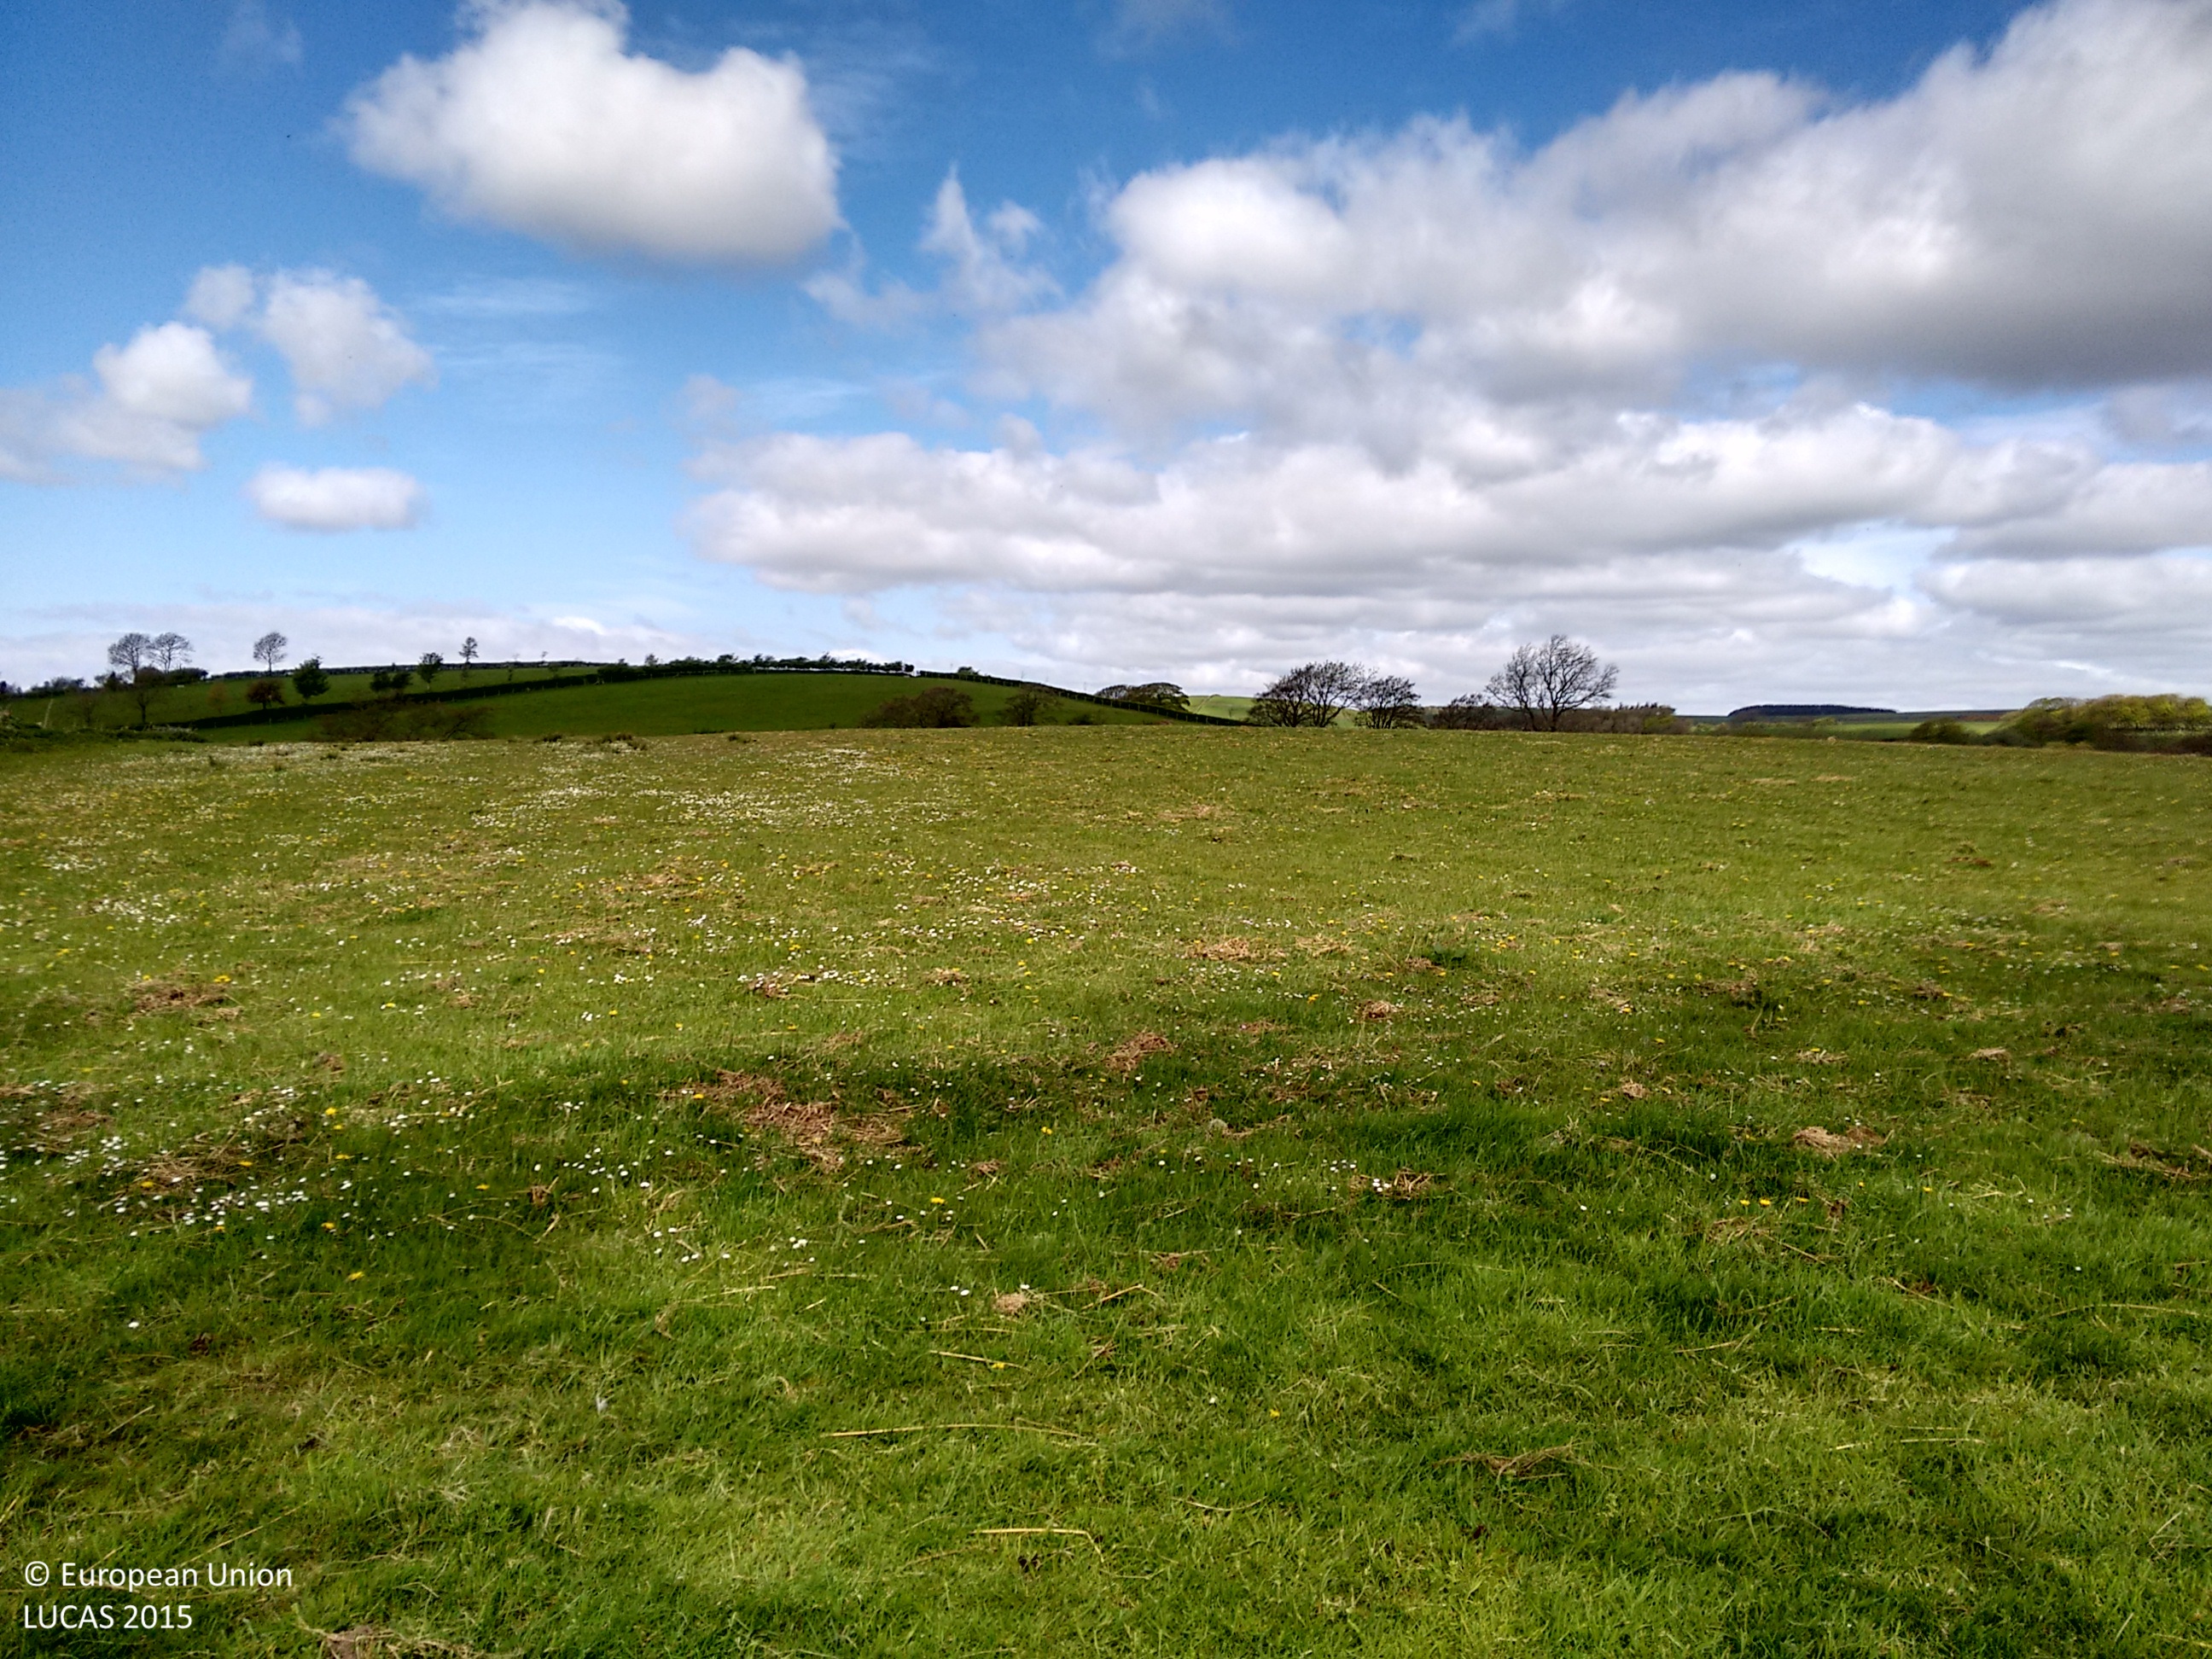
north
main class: Grassland
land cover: Grassland without tree/shrub cover
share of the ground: > 75 %
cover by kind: herbaceous plants 100 %
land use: Agriculture (excluding fallow land and kitchen gardens)
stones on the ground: < 10 %
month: May
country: GB
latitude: 54.1184
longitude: -2.6584
